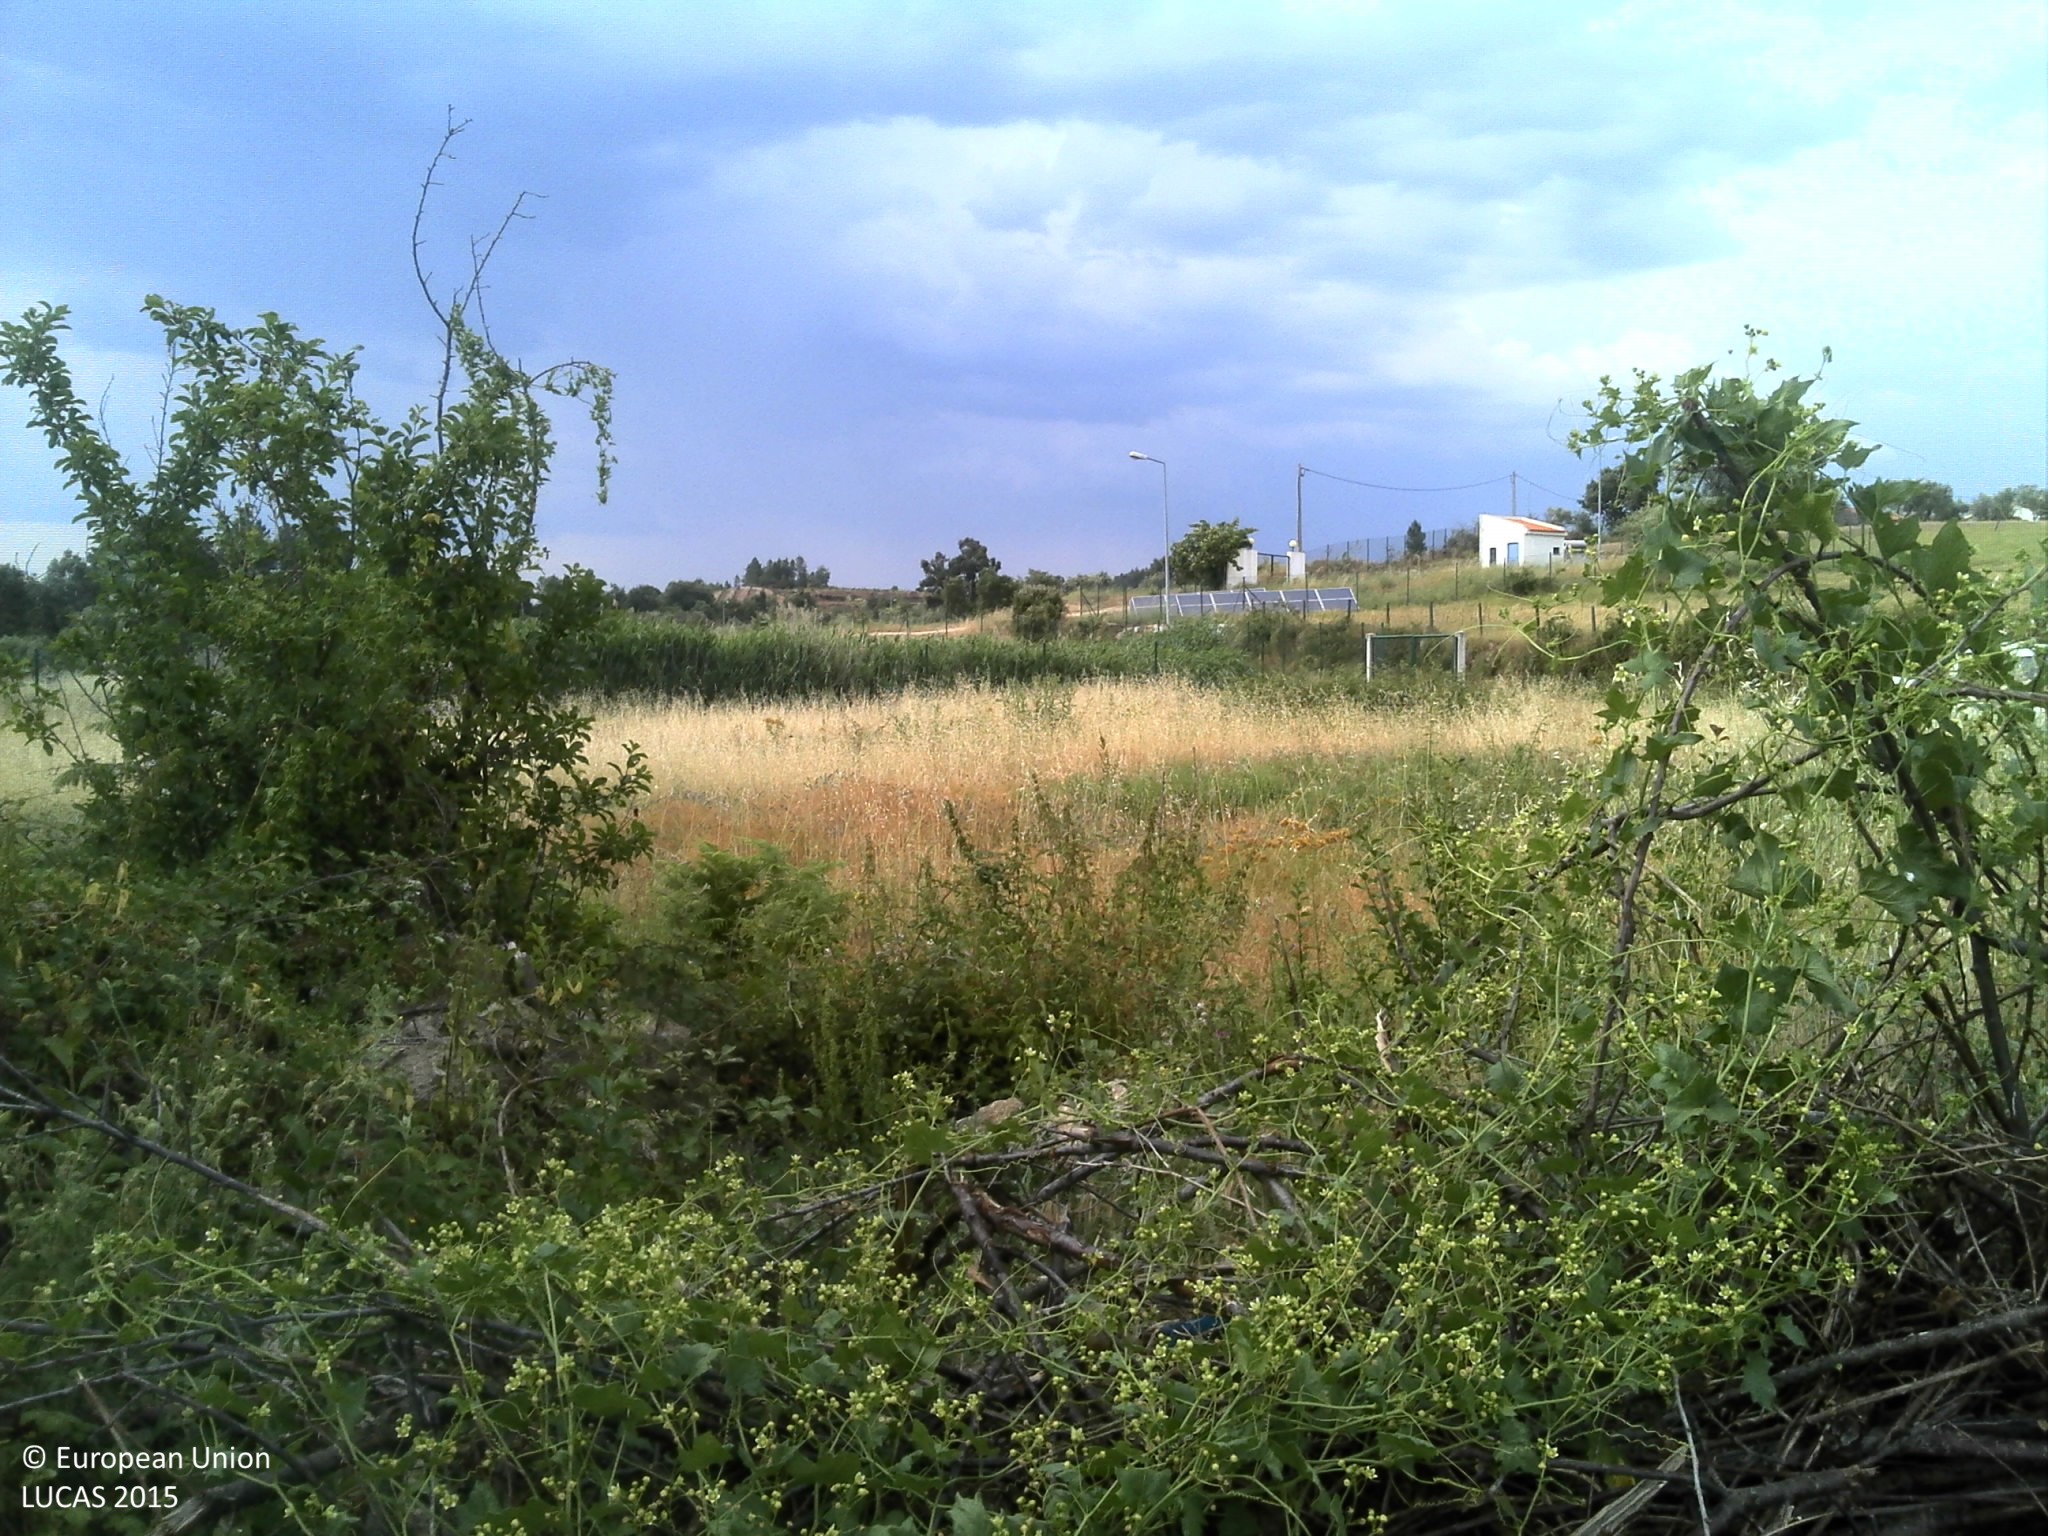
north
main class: Shrubland
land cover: Shrubland without tree cover
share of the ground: 50 - 75 %
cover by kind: shrubs 60 %, herbaceous plants 25 %, unconsolidated bare surface 10 %
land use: Agriculture (excluding fallow land and kitchen gardens)
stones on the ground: 10 - 25 %
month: June
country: PT
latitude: 40.2619
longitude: -7.3286
